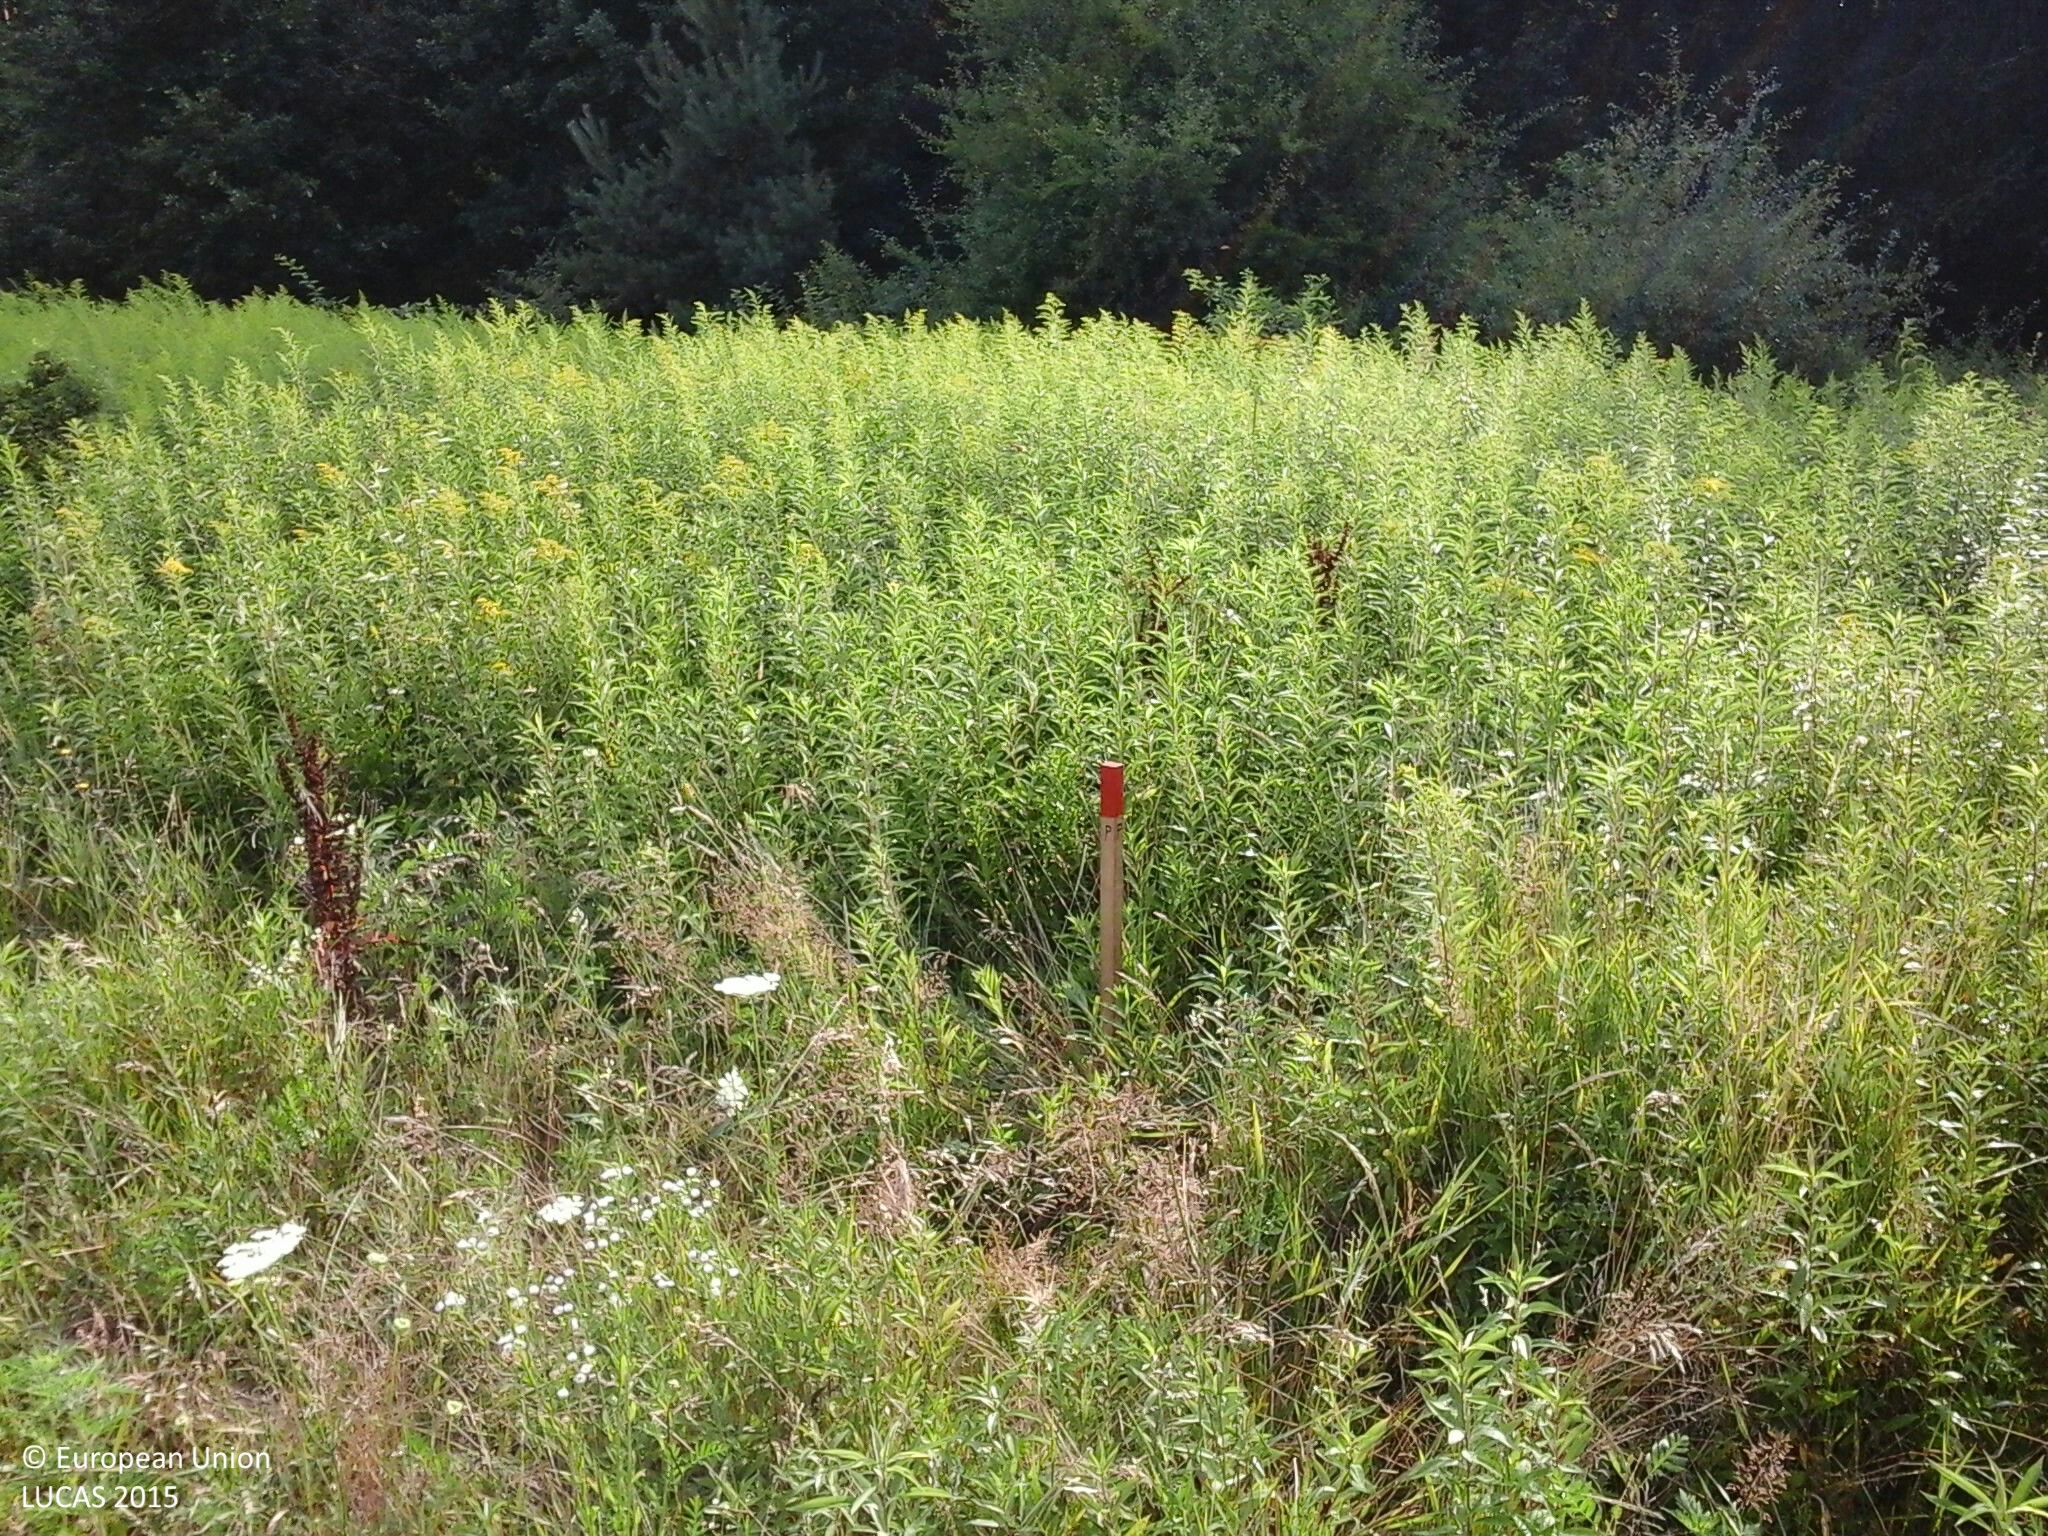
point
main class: Grassland
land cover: Grassland without tree/shrub cover
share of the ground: > 75 %
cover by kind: herbaceous plants 100 %
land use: Abandoned areas
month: July
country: HU
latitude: 46.8435
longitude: 16.4404
